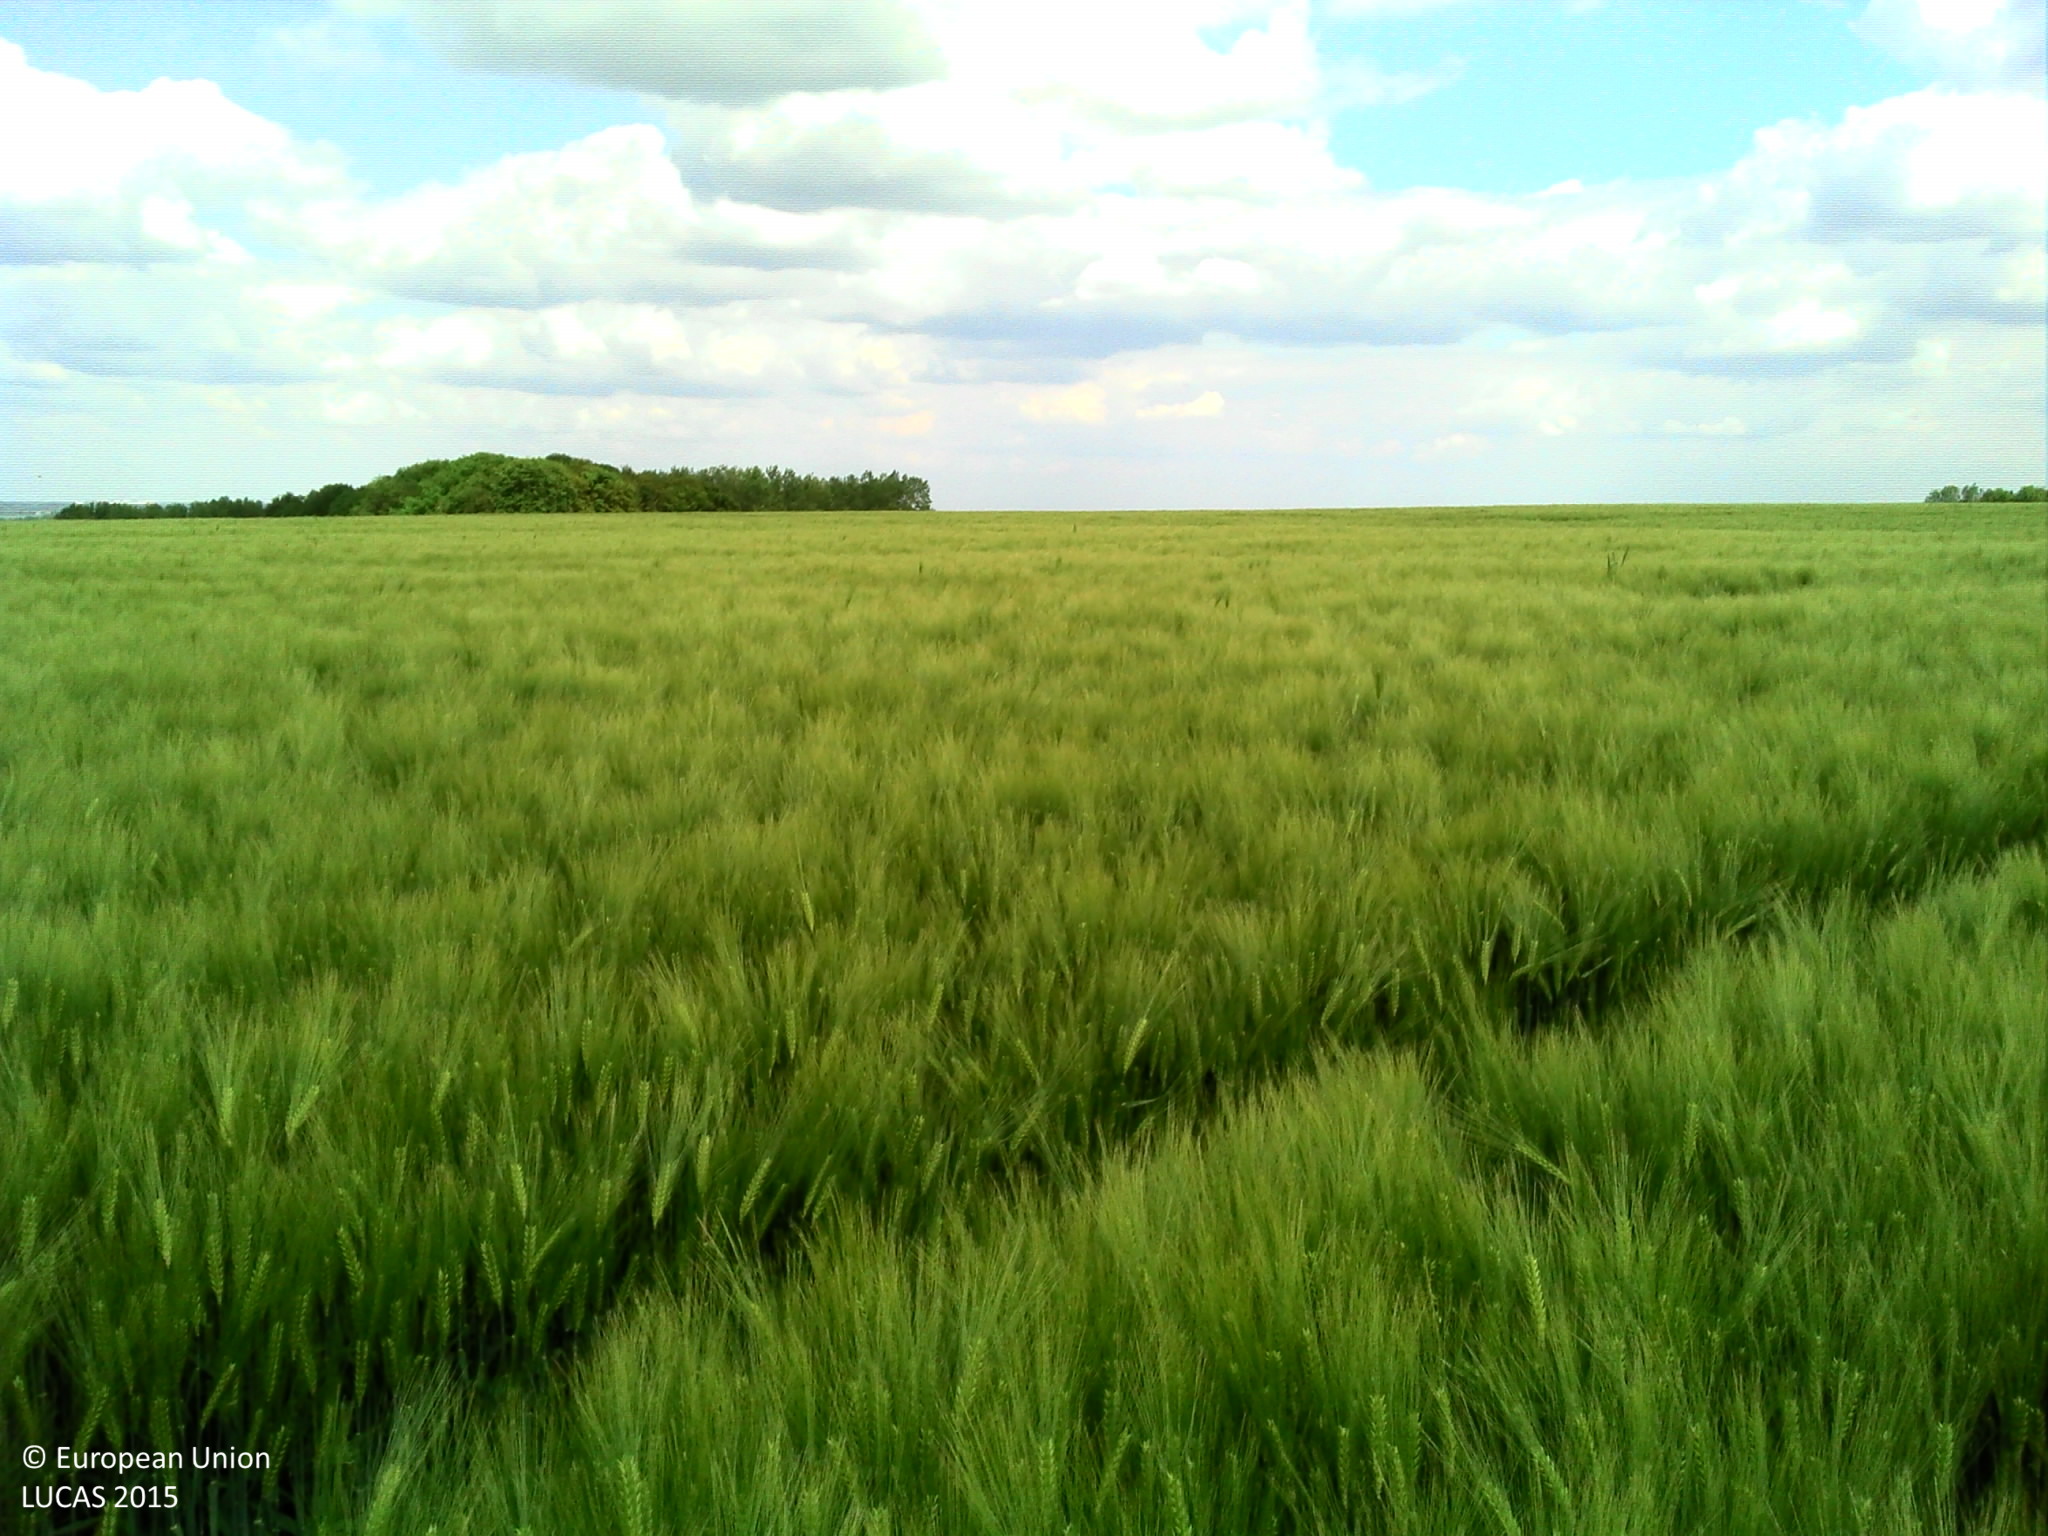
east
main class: Cropland
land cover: Barley
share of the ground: > 75 %
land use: Agriculture (excluding fallow land and kitchen gardens)
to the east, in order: Barley; Grass margins; Tracks; Grass margins; Barley
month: May
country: FR
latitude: 50.5469
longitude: 2.4369
